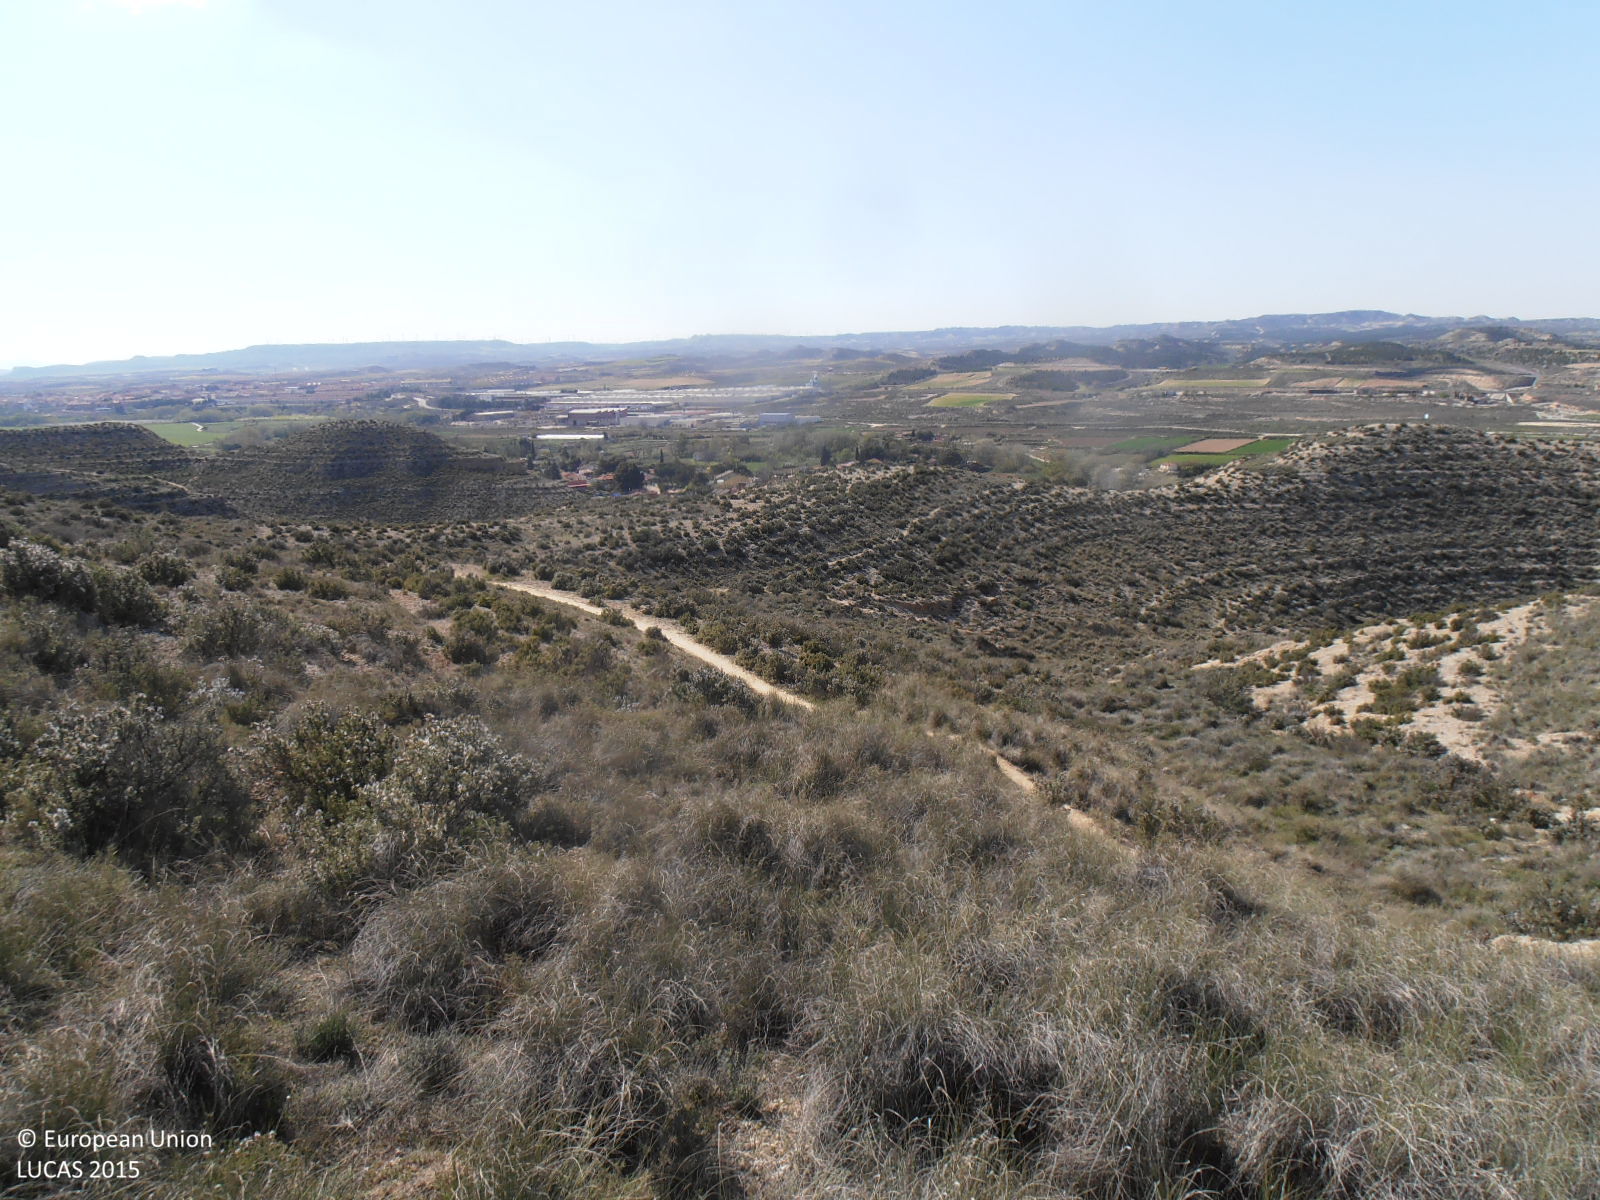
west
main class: Shrubland
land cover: Shrubland without tree cover
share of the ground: 50 - 75 %
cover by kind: shrubs 55 %, consolidated bare surface 45 %
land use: Semi-natural and natural areas not in use
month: April
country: ES
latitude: 41.5467
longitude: -0.9666
